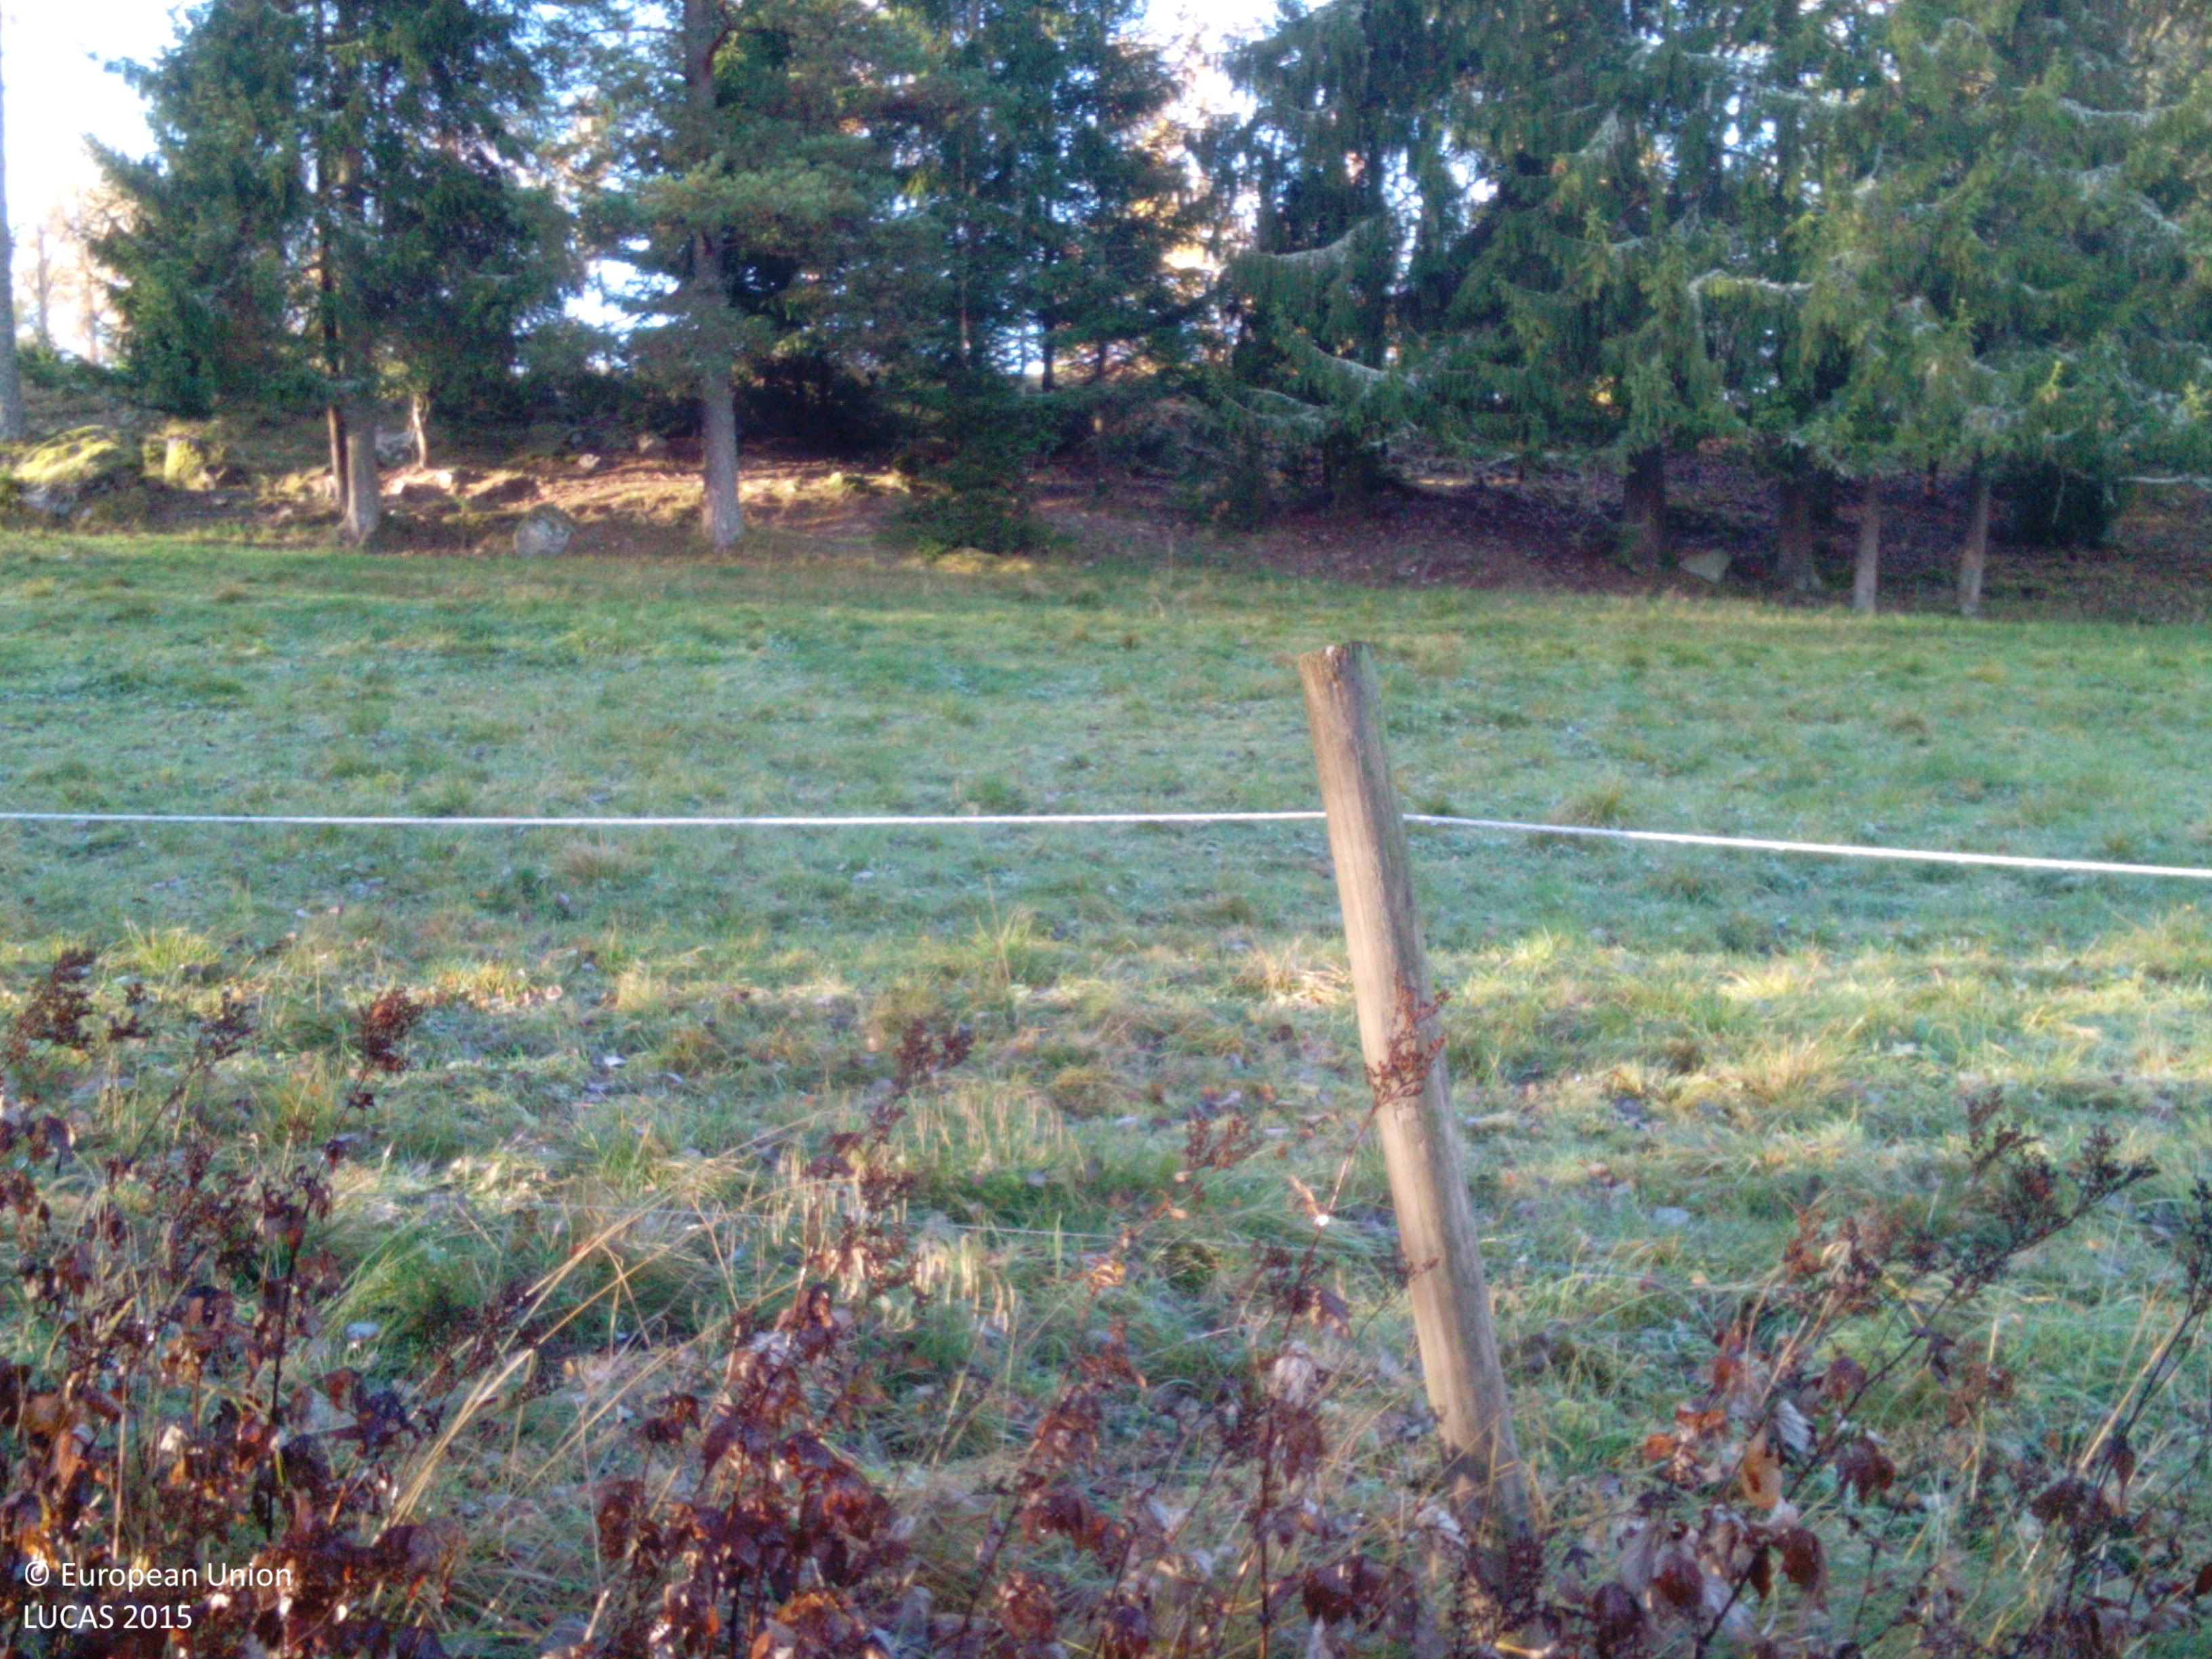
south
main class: Woodland
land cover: Broadleaved woodland
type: hemiboreal forest and nemoral coniferous forest and mixed broadleaved-coniferous forest
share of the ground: 25 - 50 %
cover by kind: herbaceous plants 60 %, broadleaved forest trees 40 %
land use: Semi-natural and natural areas not in use
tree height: > 5 m
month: October
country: SE
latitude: 59.1173
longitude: 16.3341
